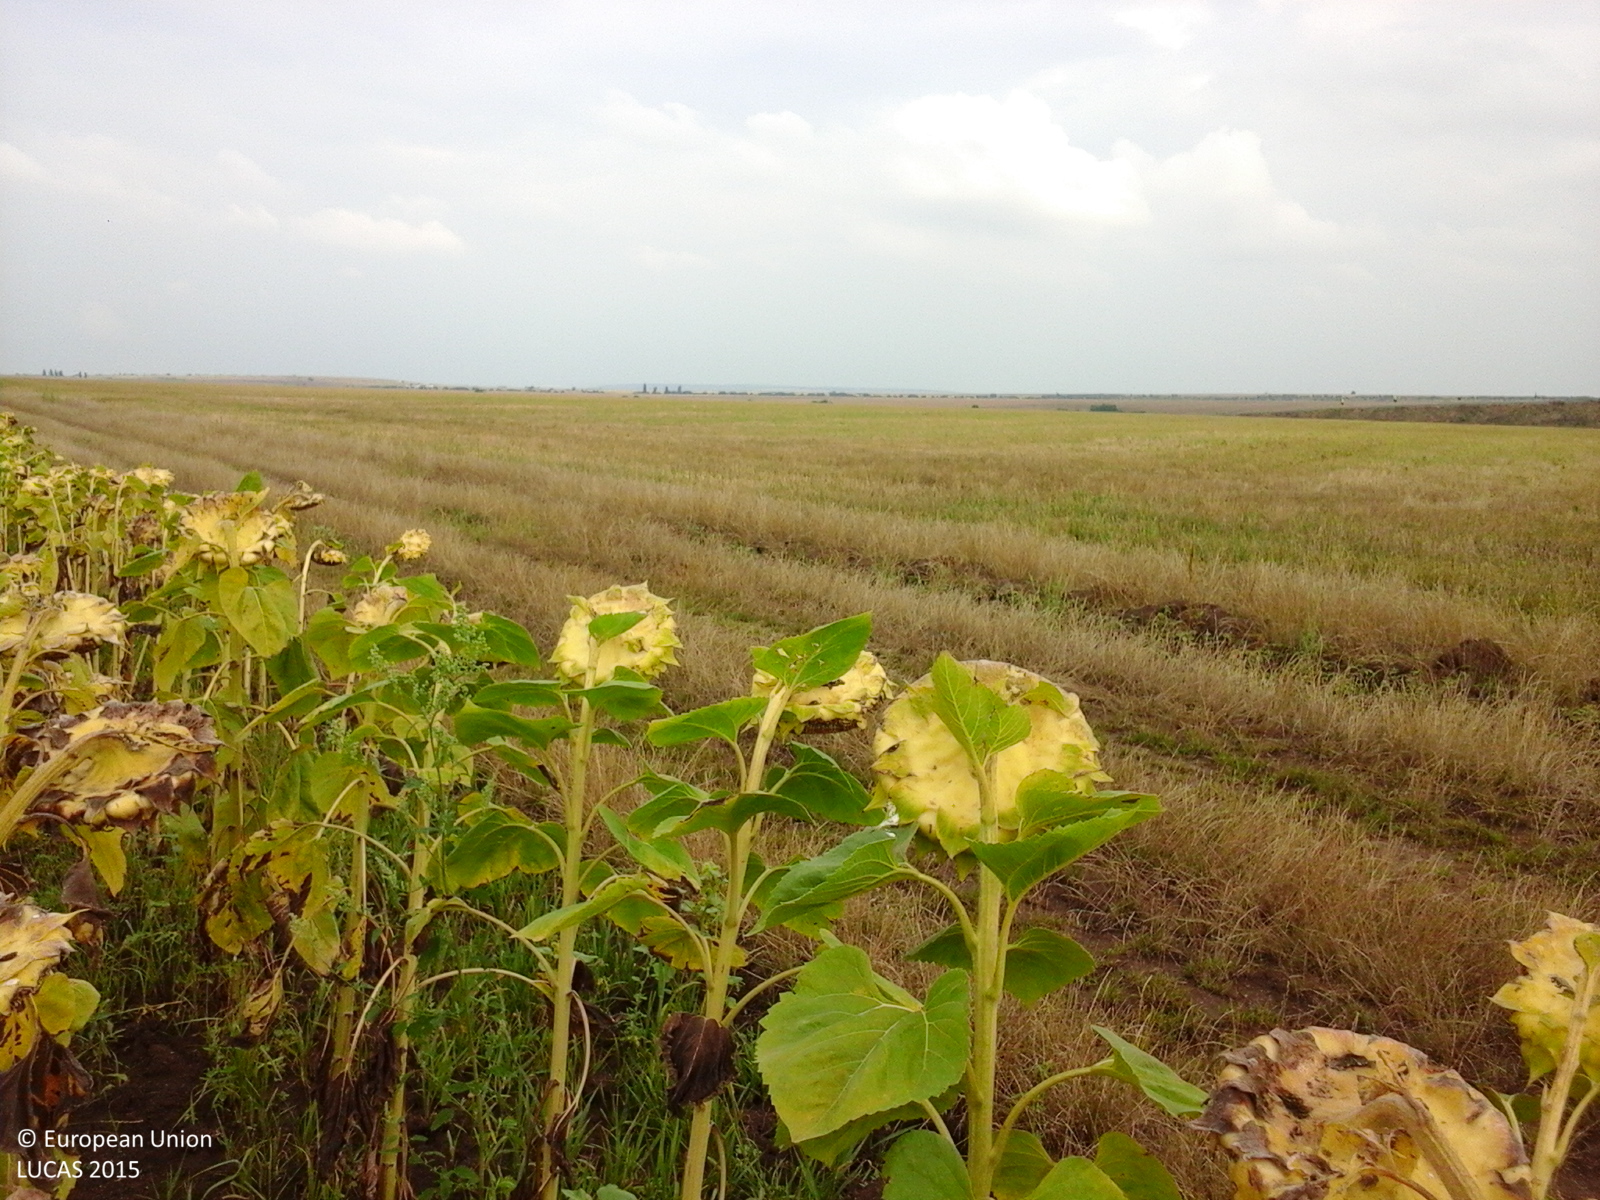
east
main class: Cropland
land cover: Sunflower
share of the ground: > 75 %
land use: Agriculture (excluding fallow land and kitchen gardens)
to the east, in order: Sunflower; Grass margins; Tracks; Grass margins; Common wheat
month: August
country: RO
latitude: 45.8565
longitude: 21.3273
